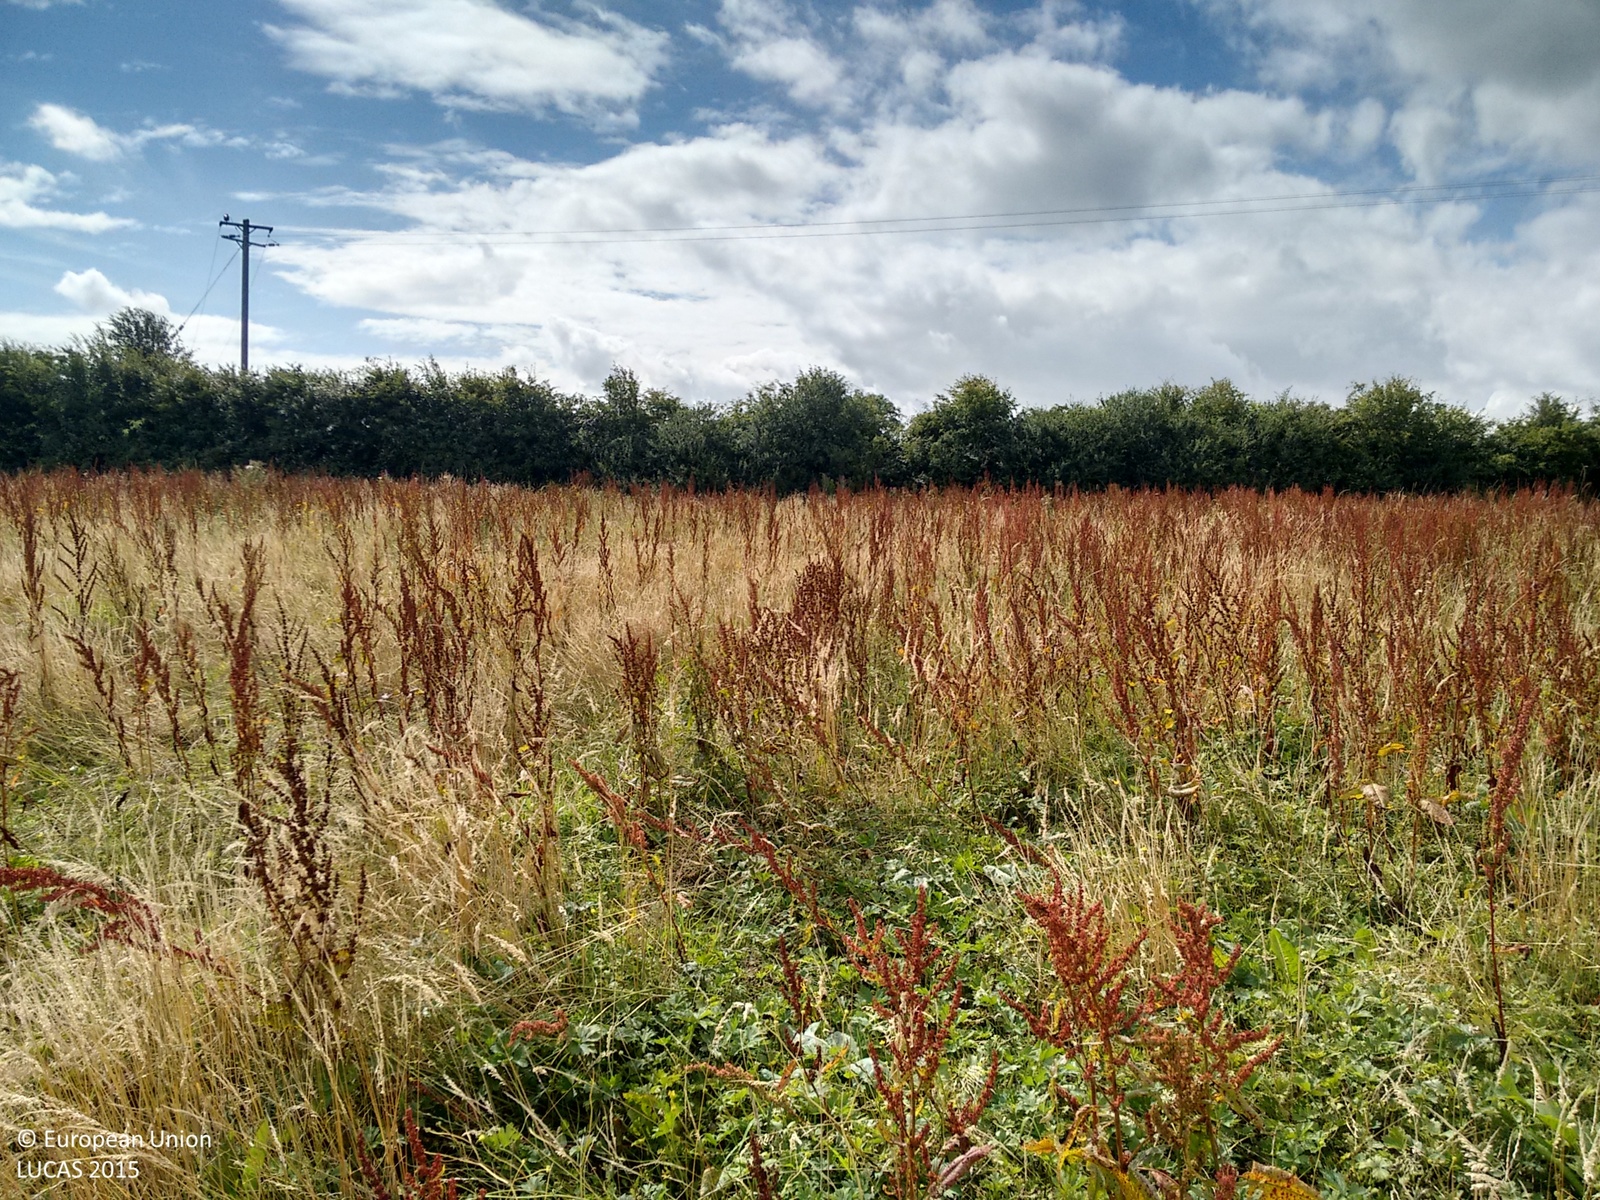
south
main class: Grassland
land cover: Spontaneously vegetated surfaces
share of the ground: > 75 %
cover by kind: herbaceous plants 95 %, shrubs 5 %
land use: Fallow land
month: August
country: IE
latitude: 53.8133
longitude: -6.4201
